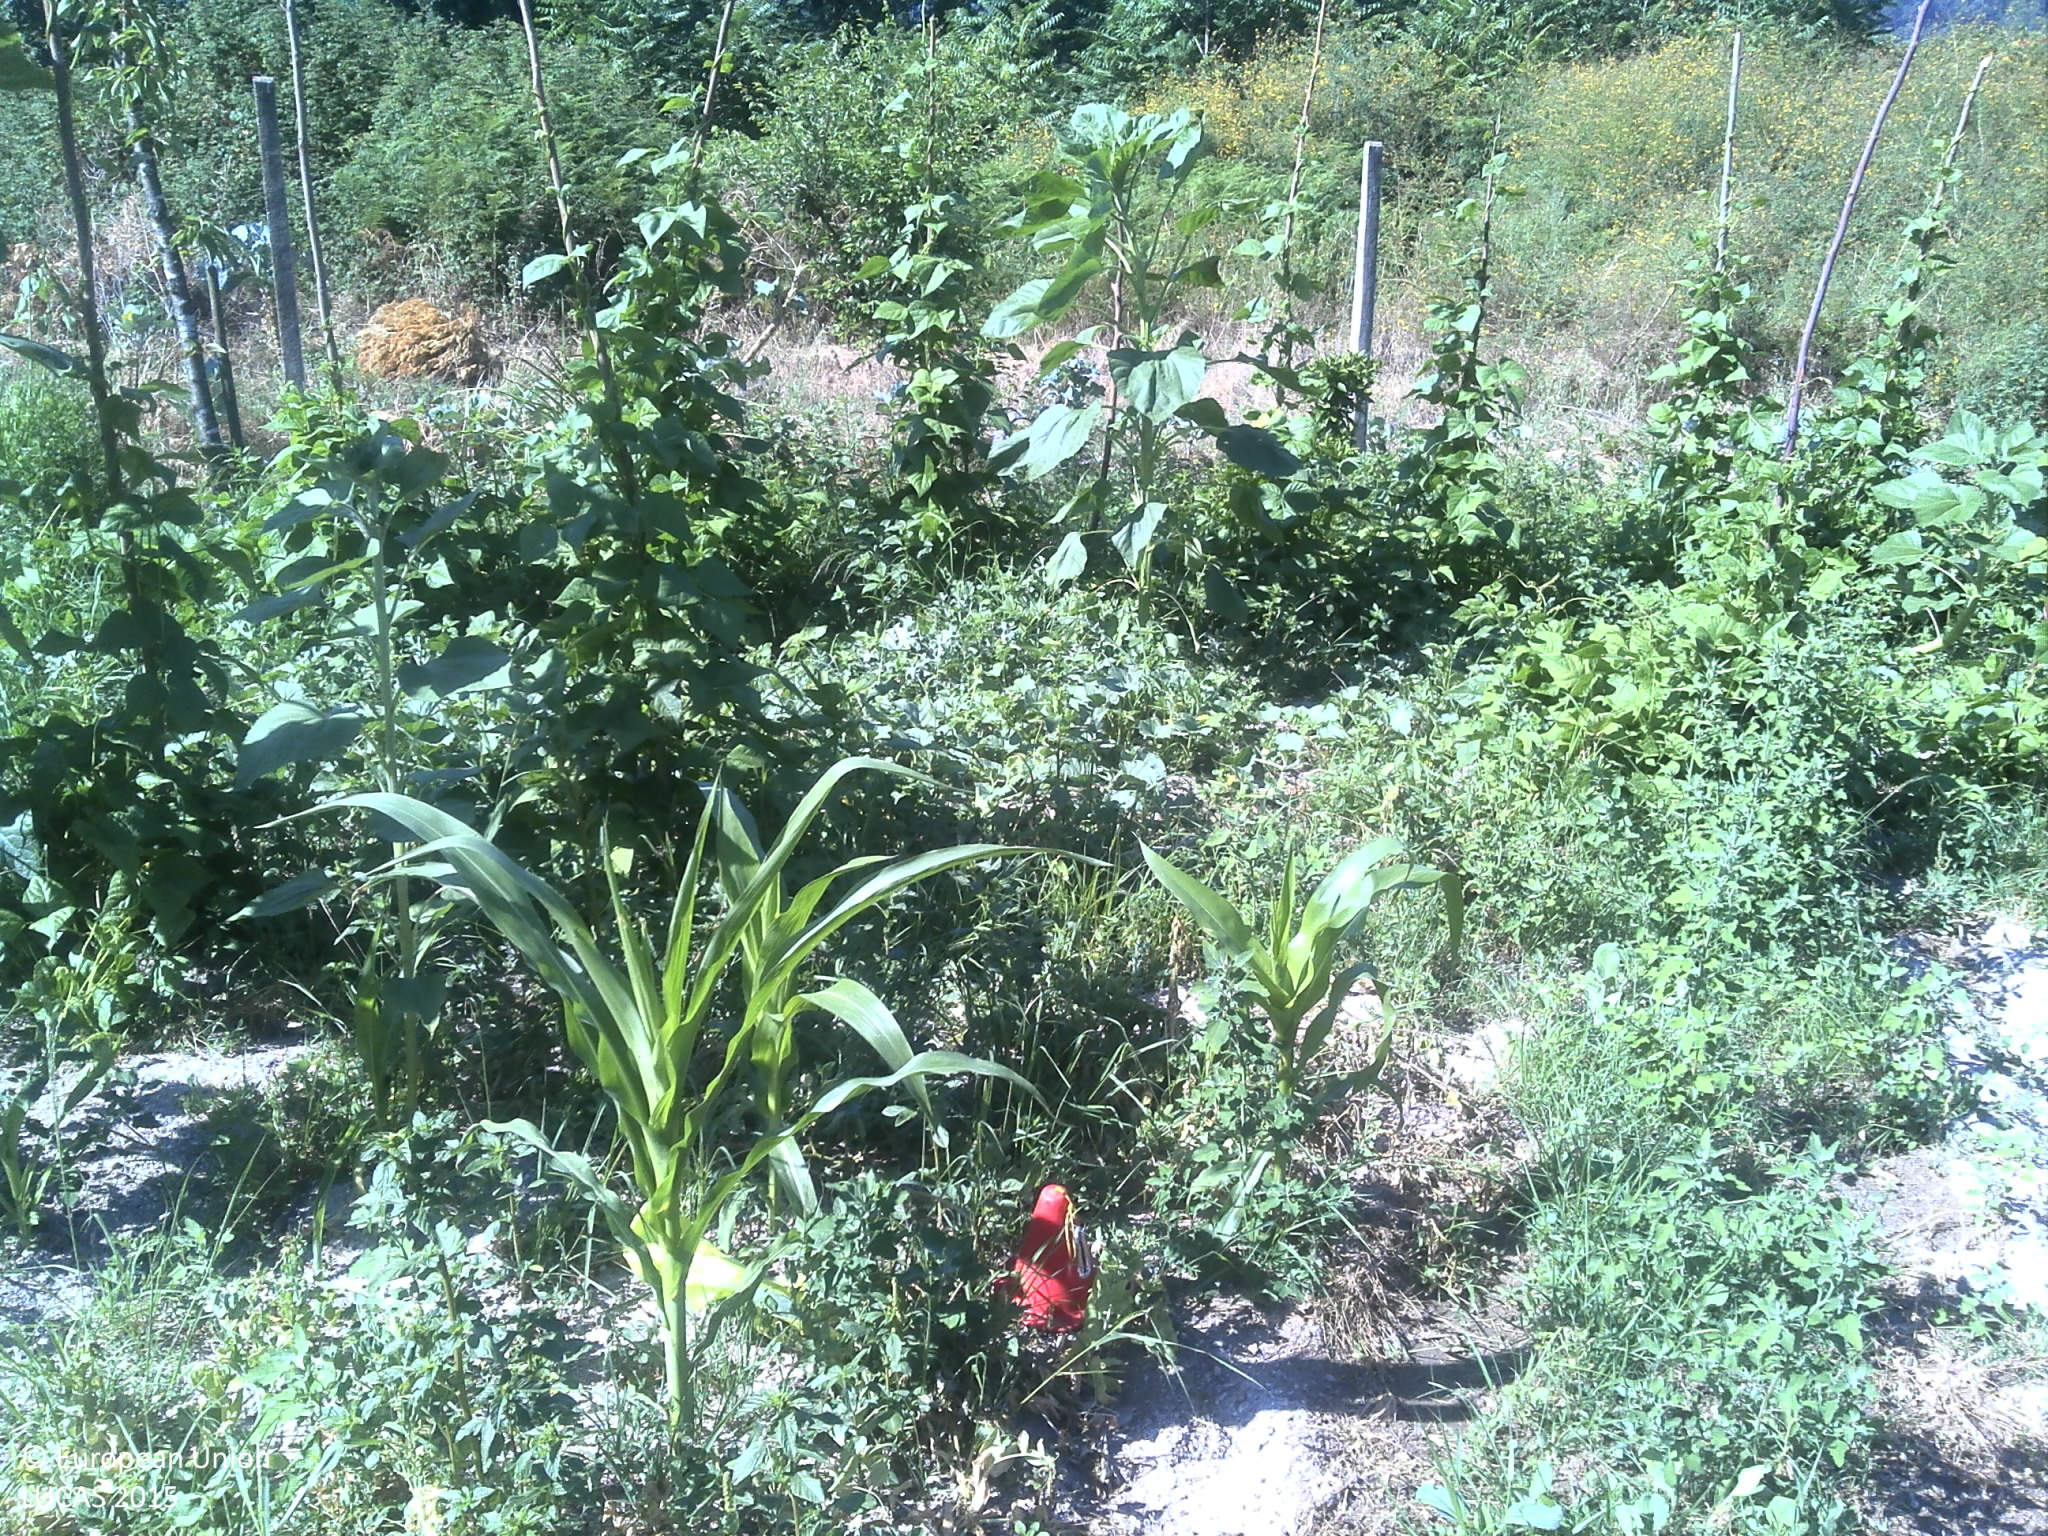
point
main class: Cropland
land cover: Other fresh vegetables
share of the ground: 25 - 50 %
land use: Kitchen garden
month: June
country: PT
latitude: 41.2999
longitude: -8.1146
